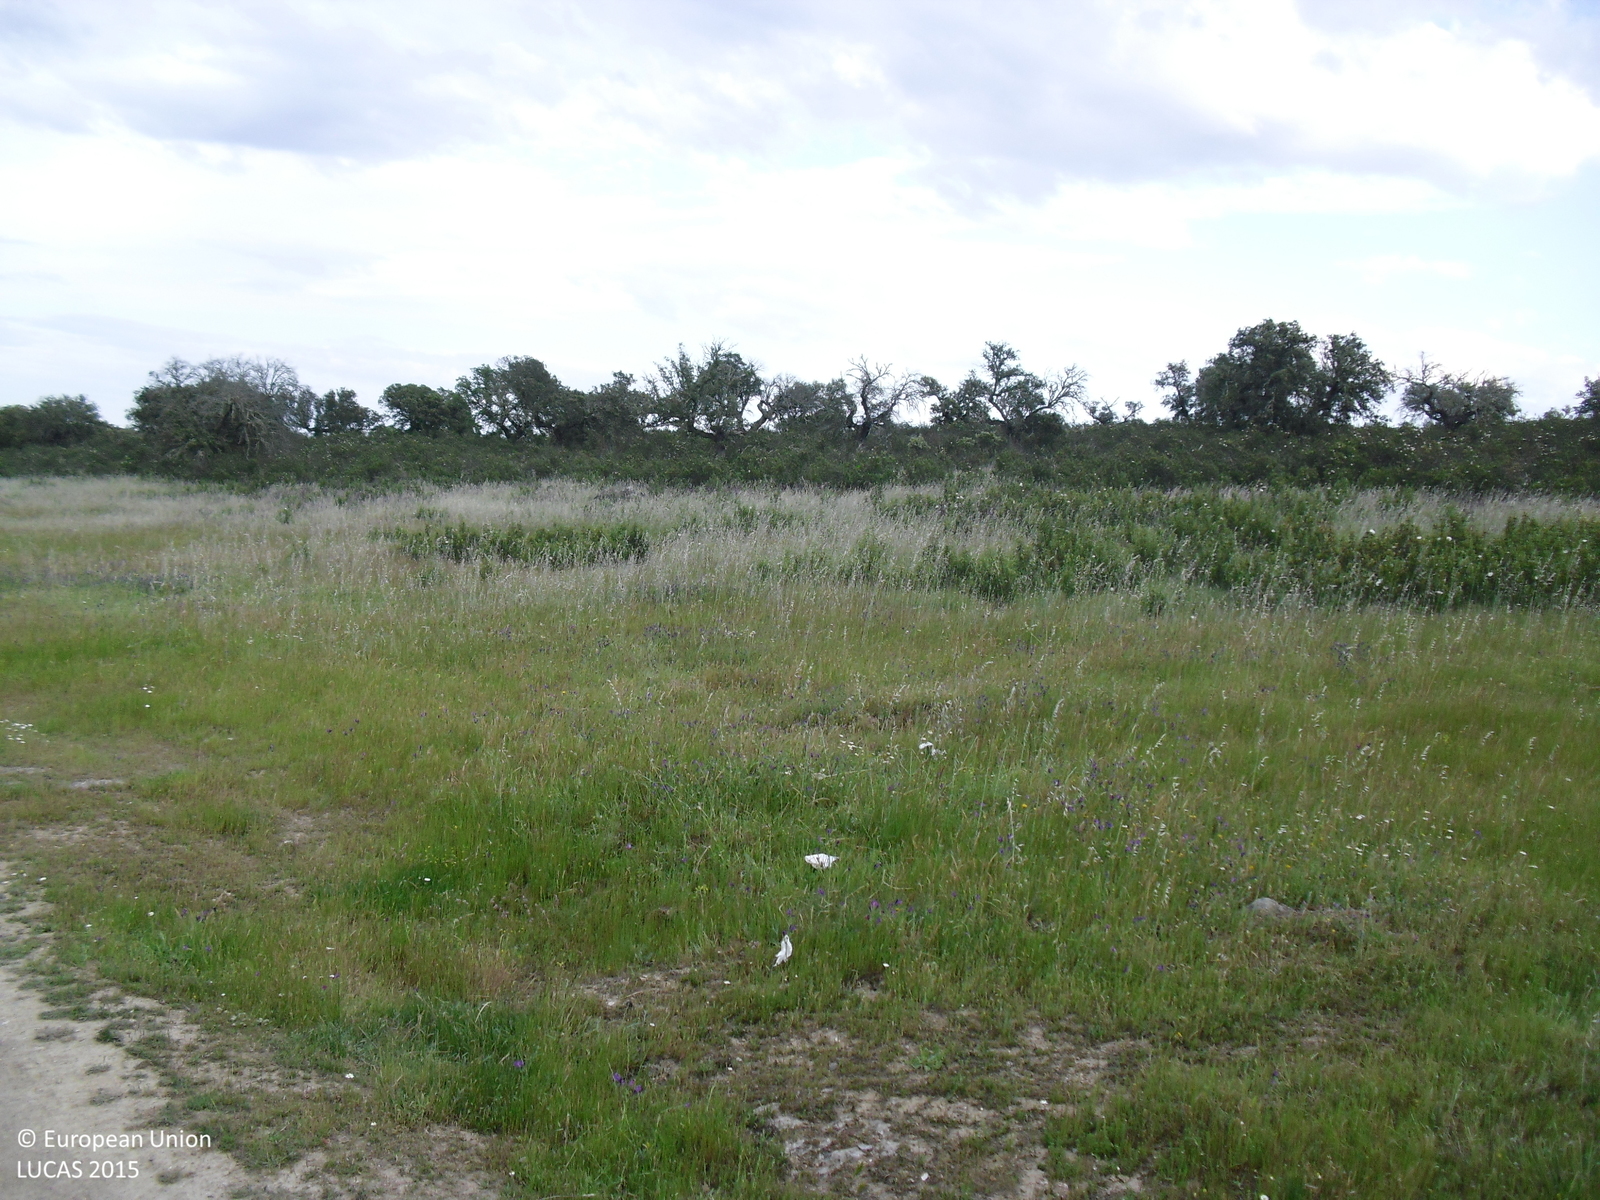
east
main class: Shrubland
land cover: Shrubland with sparse tree cover
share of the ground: > 75 %
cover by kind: shrubs 50 %, herbaceous plants 45 %, broadleaved forest trees 5 %
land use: Agriculture (excluding fallow land and kitchen gardens)
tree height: > 5 m
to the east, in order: Shrubland with sparse tree cover; Grassland with sparse tree/shrub cover; Broadleaved woodland; Grassland with sparse tree/shrub cover
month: April
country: ES
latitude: 39.4271
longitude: -6.6263
